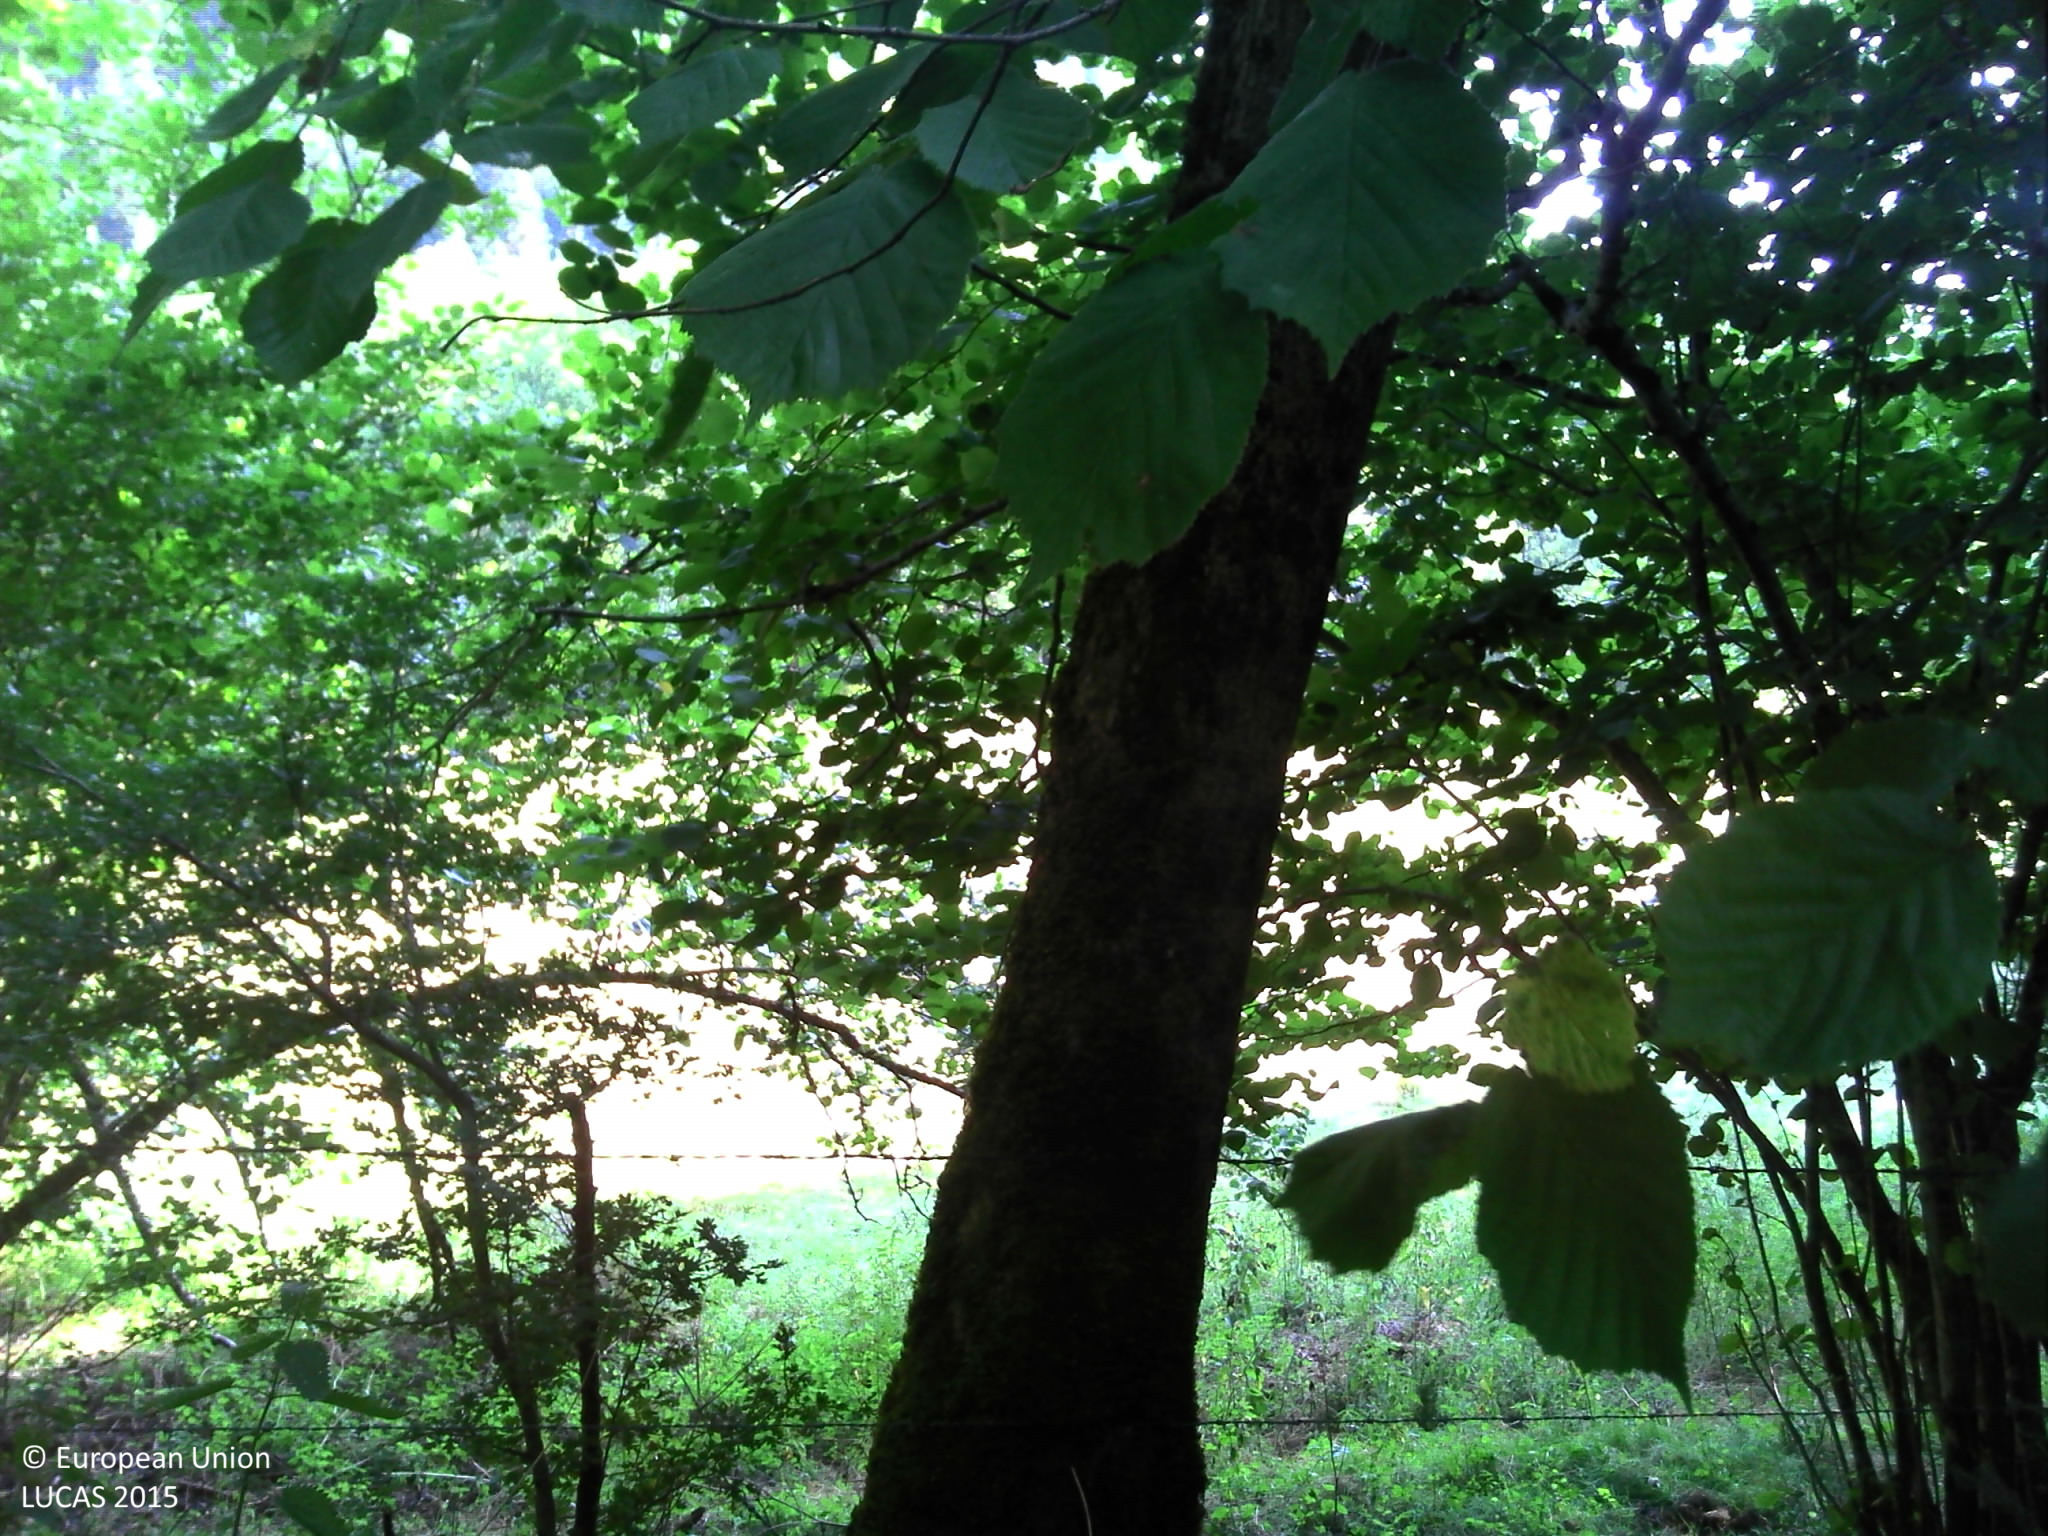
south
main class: Woodland
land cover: Broadleaved woodland
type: mesophytic deciduous forest
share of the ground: > 75 %
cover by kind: broadleaved forest trees 80 %, shrubs 10 %, herbaceous plants 10 %
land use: Forestry
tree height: > 5 m
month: July
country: FR
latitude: 45.2204
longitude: 4.2353
